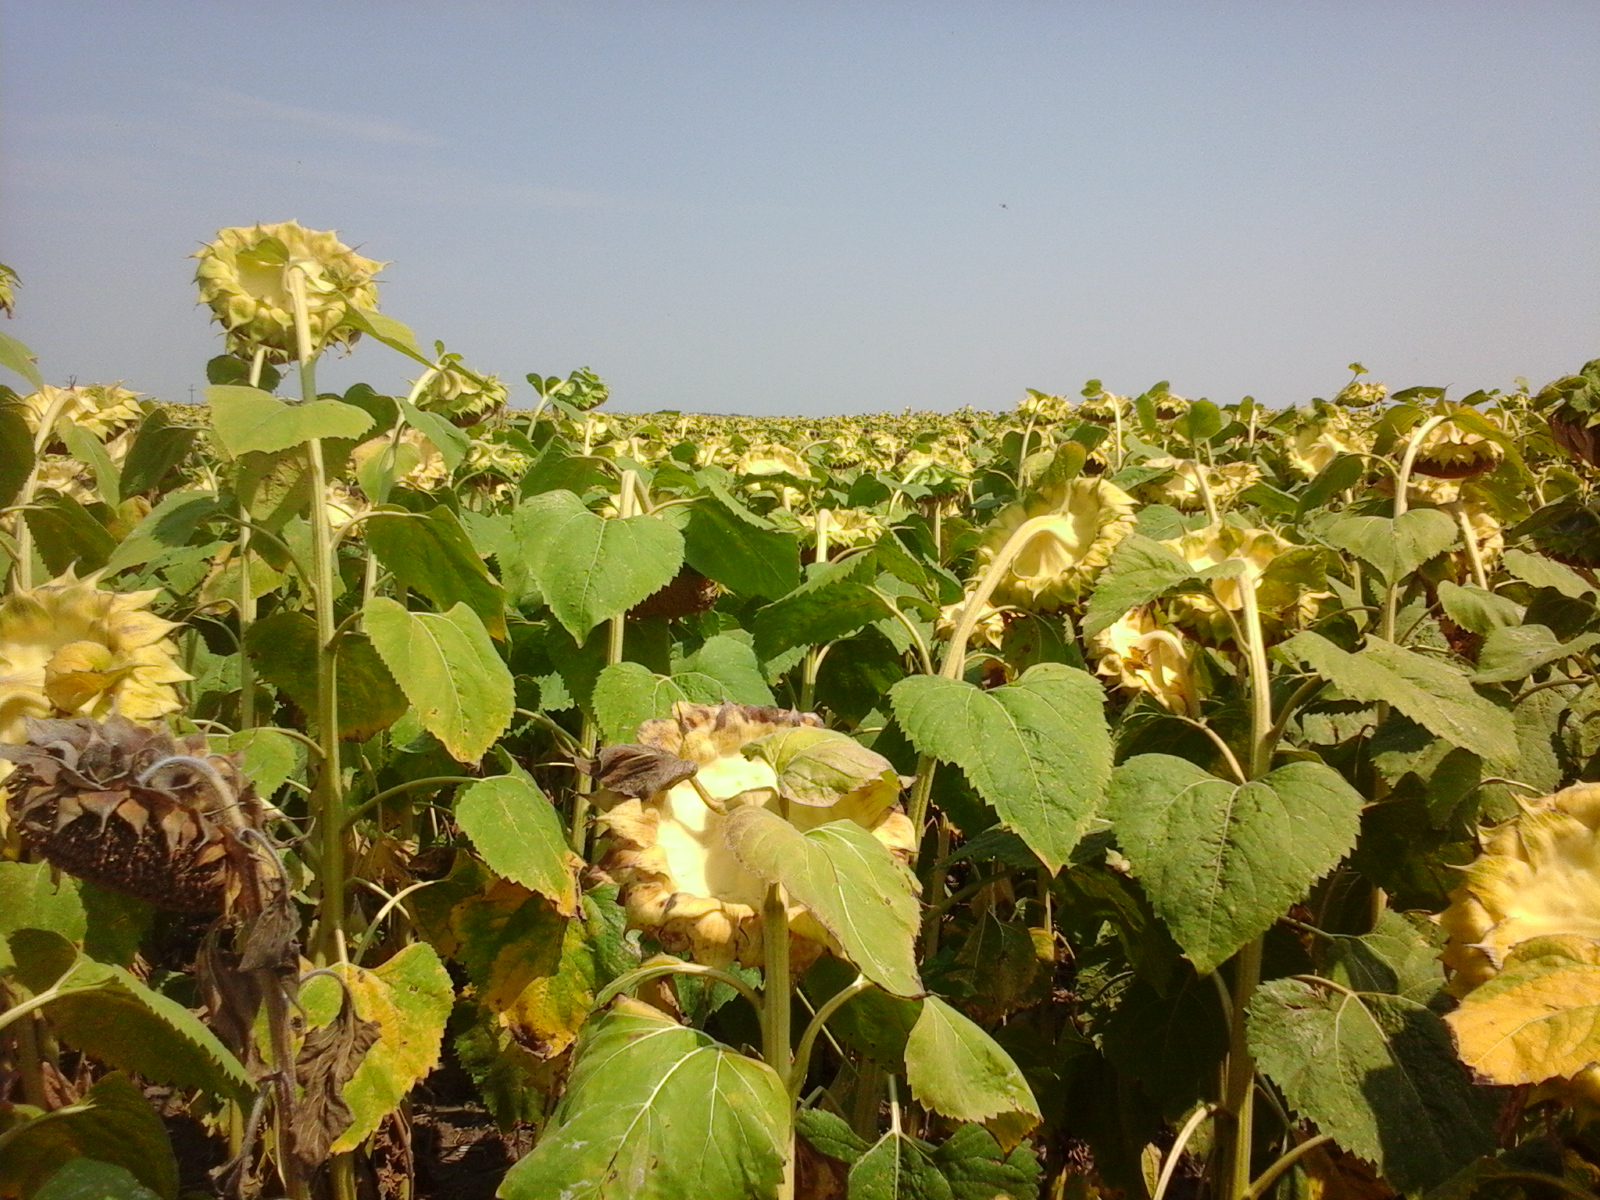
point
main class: Cropland
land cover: Sunflower
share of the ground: > 75 %
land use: Agriculture (excluding fallow land and kitchen gardens)
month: August
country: RO
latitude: 43.8994
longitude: 23.6585
